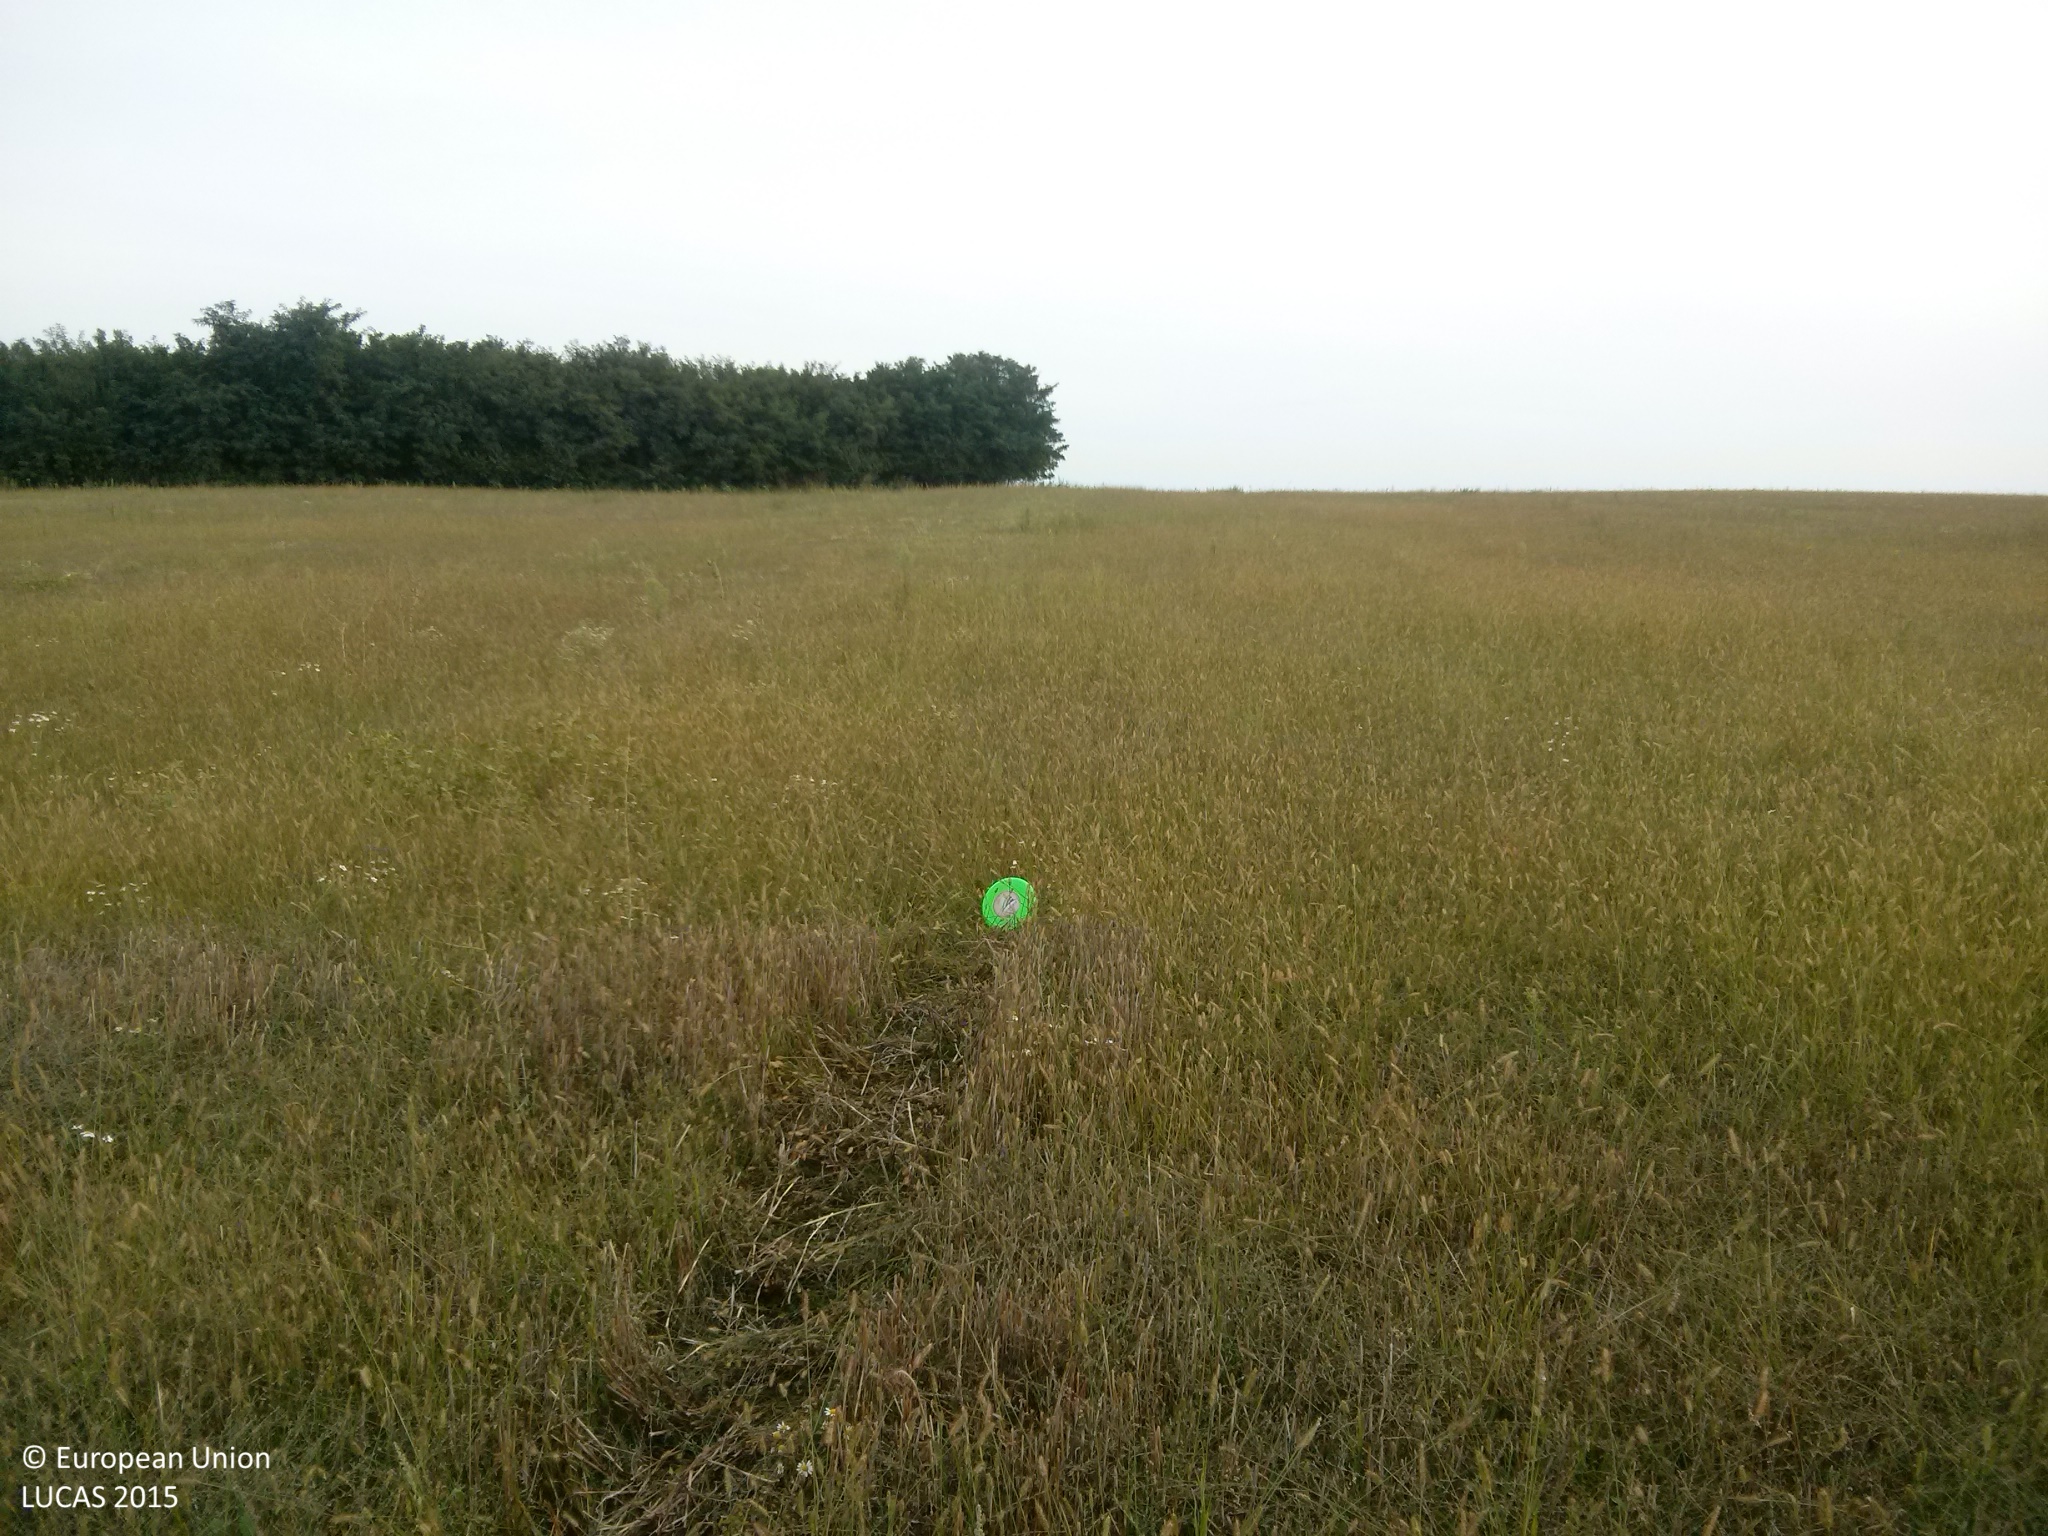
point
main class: Cropland
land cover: Common wheat
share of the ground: 10 - 25 %
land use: Agriculture (excluding fallow land and kitchen gardens)
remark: Harvested field
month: September
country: BG
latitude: 43.7480
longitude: 26.3088
